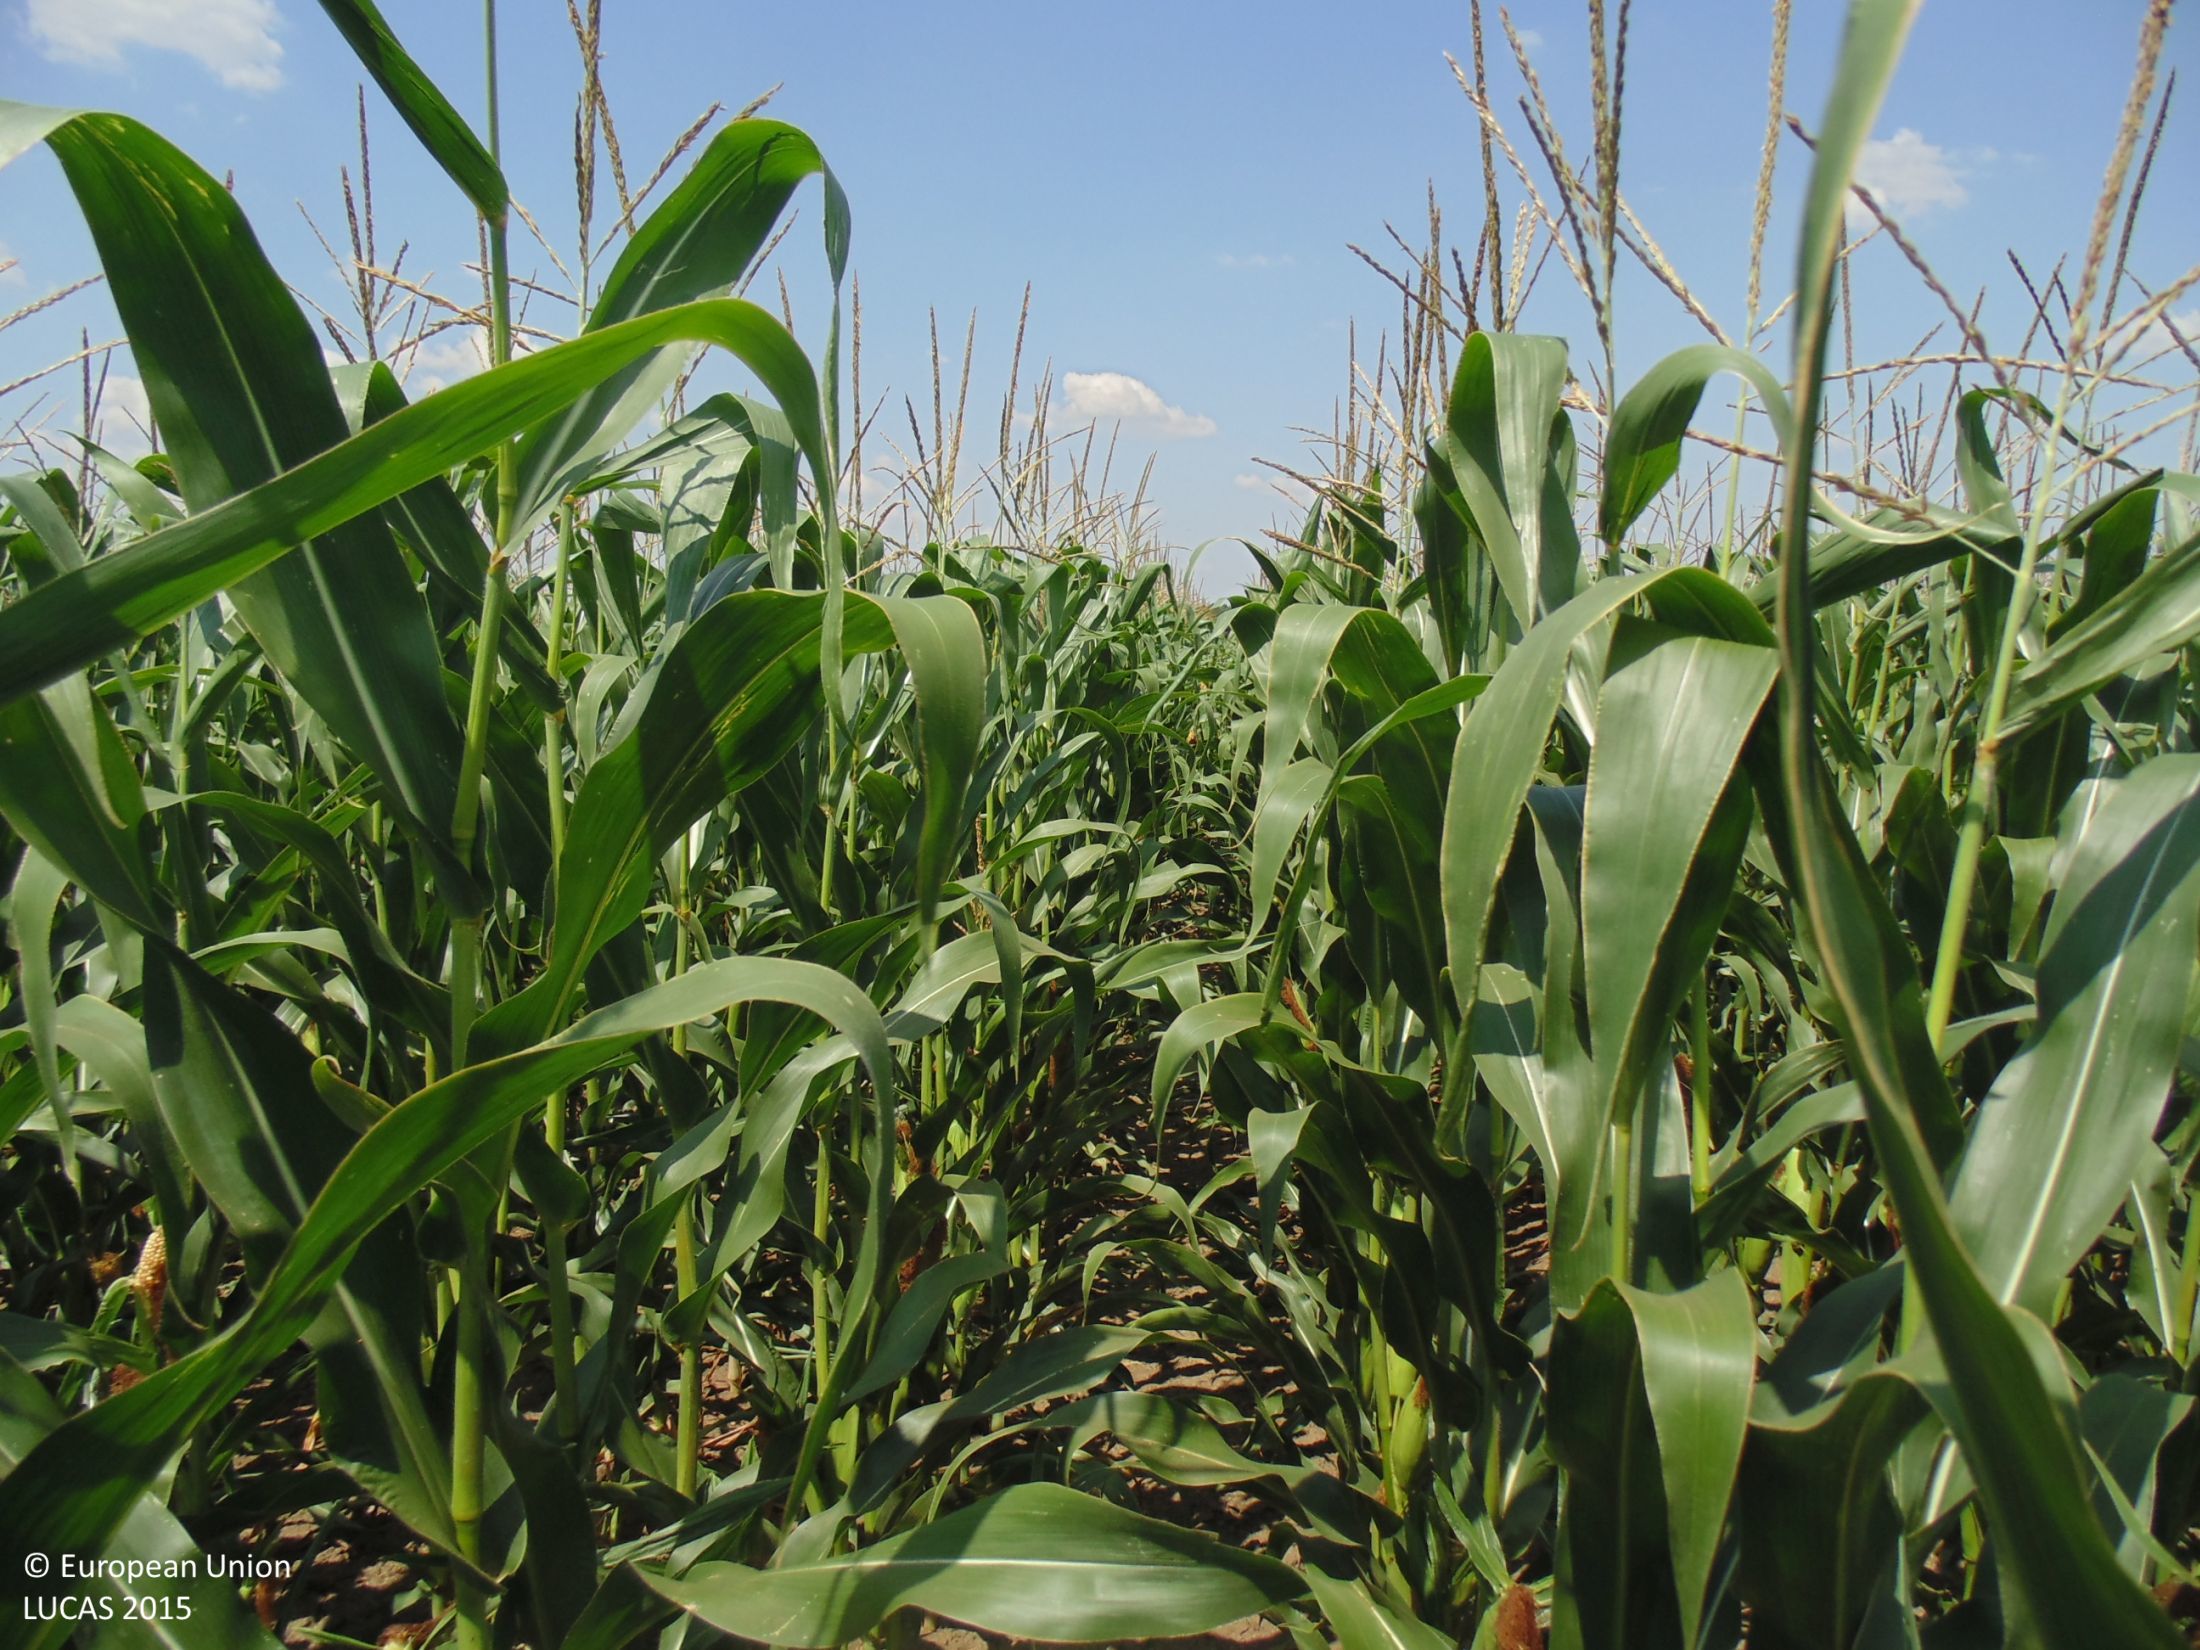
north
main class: Cropland
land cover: Maize
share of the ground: > 75 %
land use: Agriculture (excluding fallow land and kitchen gardens)
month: July
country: BG
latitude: 43.8310
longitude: 27.8922
